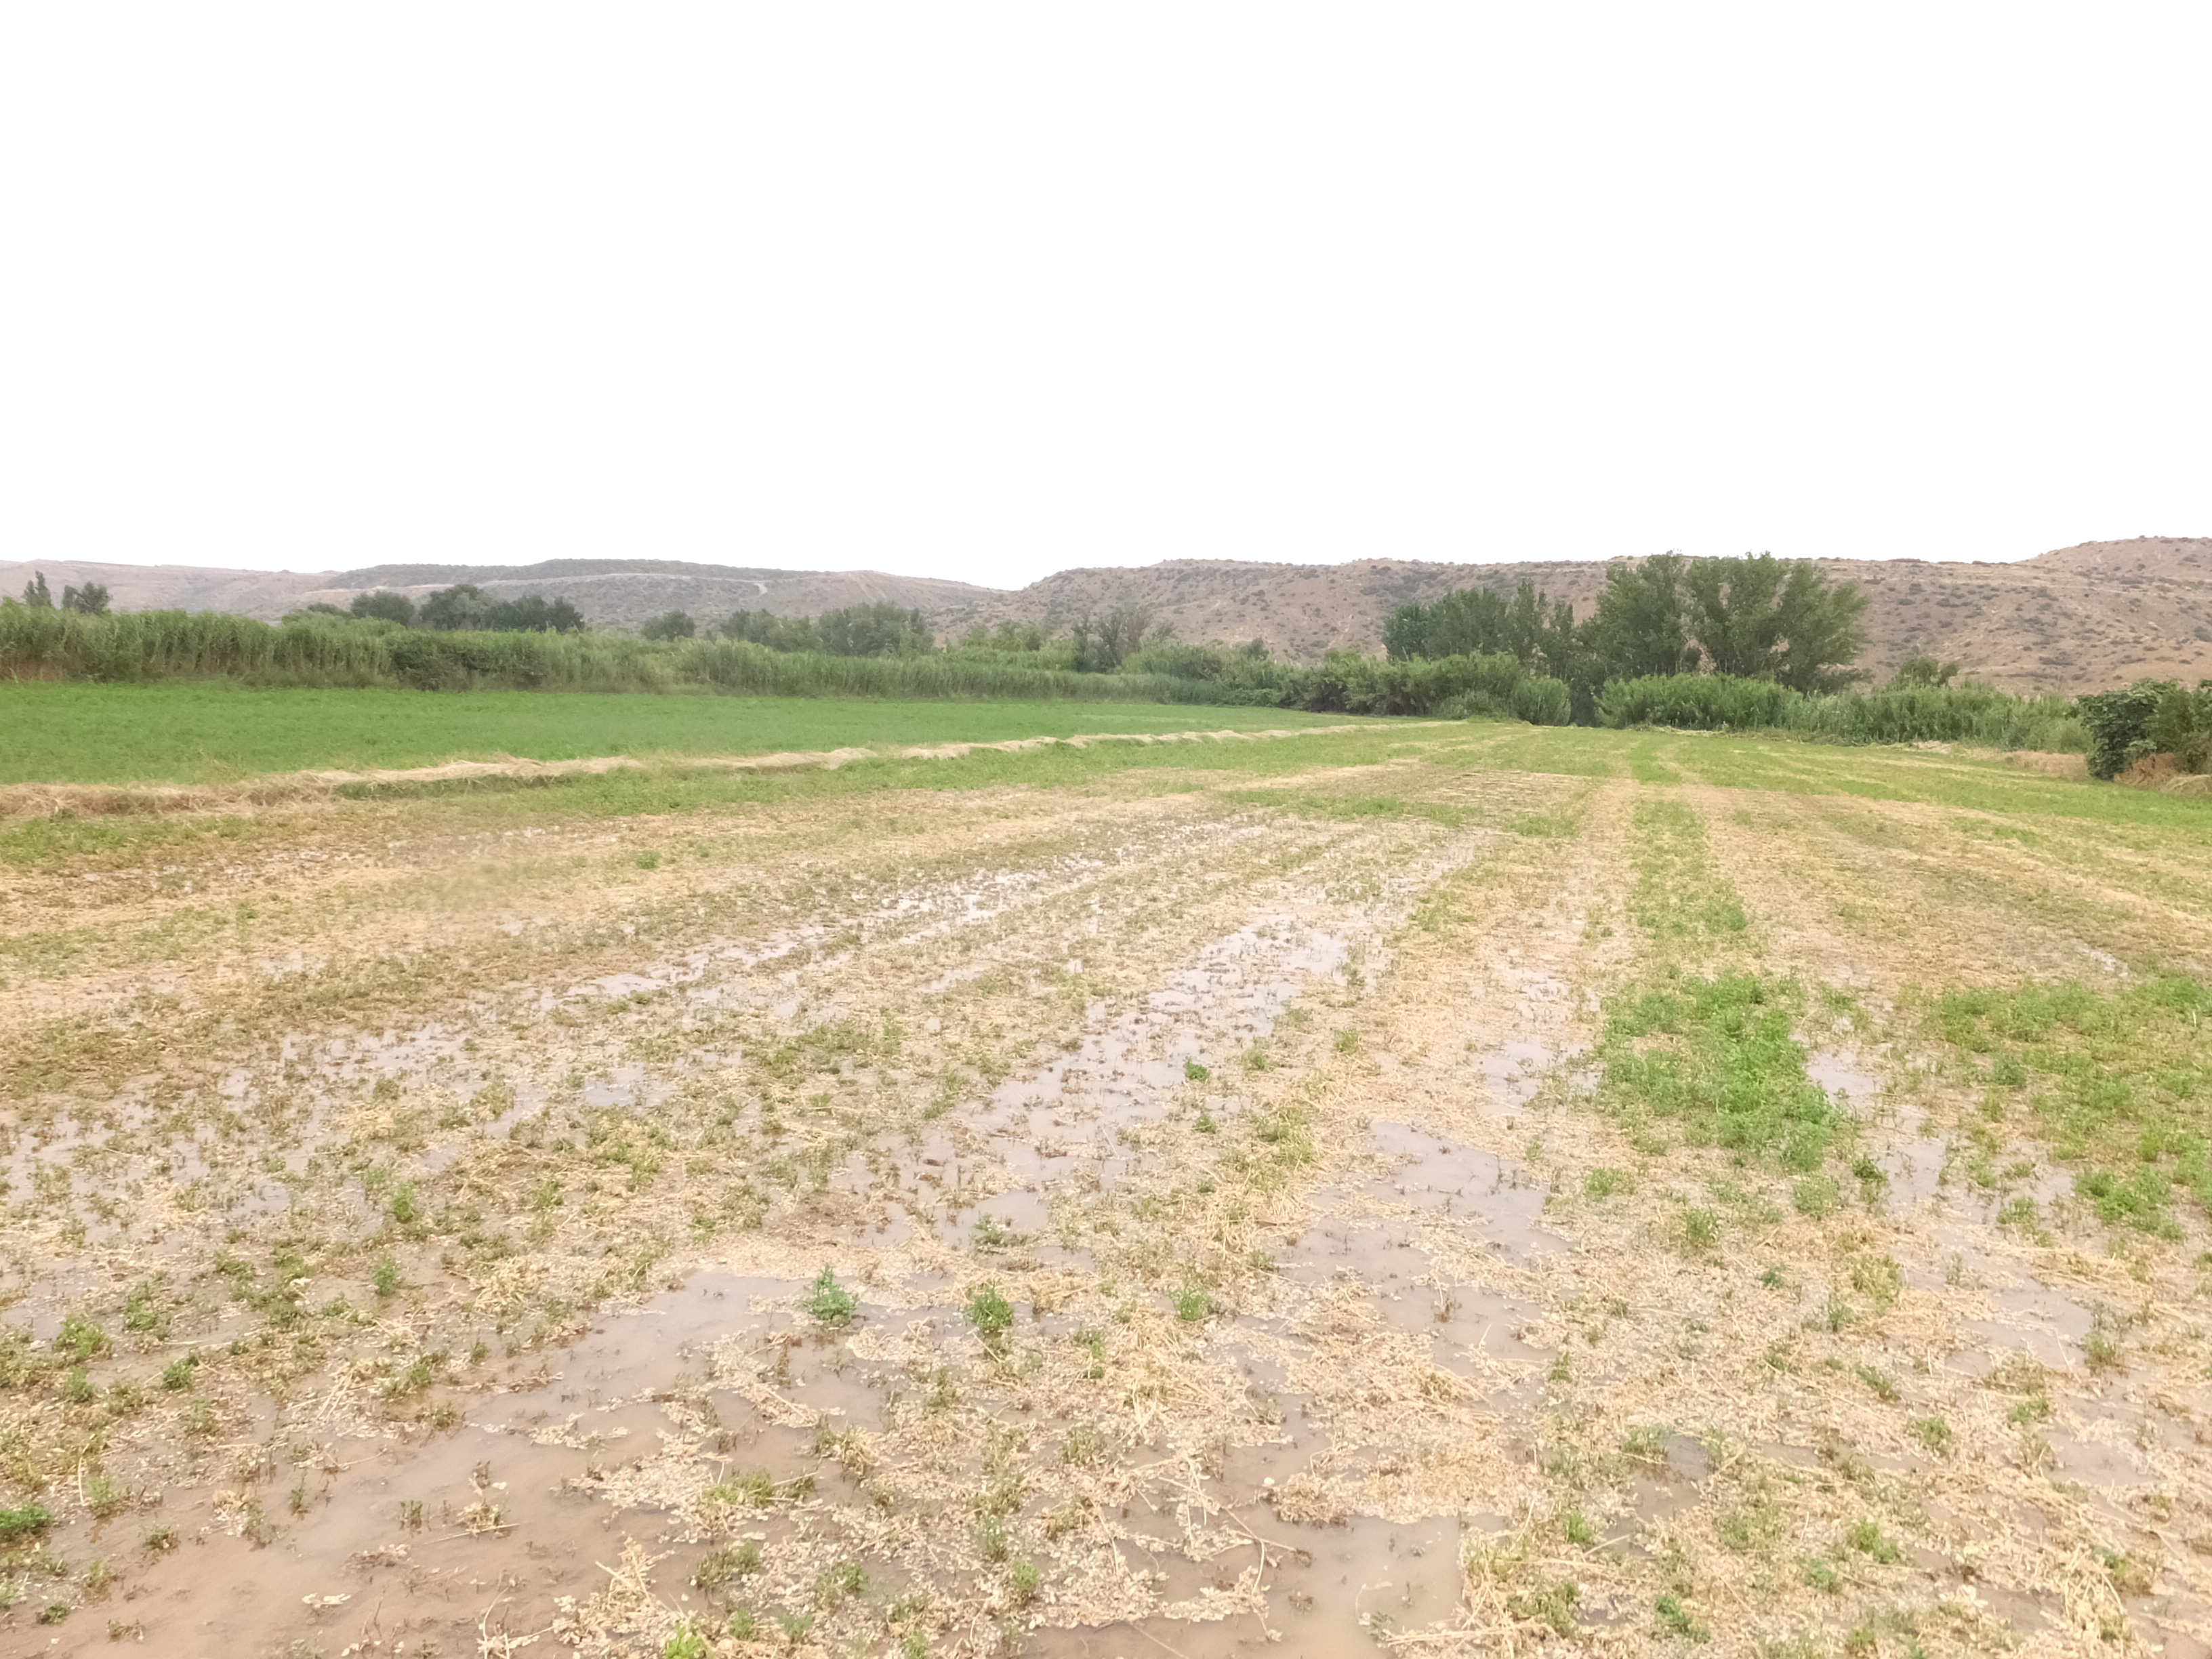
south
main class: Cropland
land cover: Lucerne
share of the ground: > 75 %
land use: Agriculture (excluding fallow land and kitchen gardens)
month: July
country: ES
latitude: 41.6635
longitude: 0.1489
